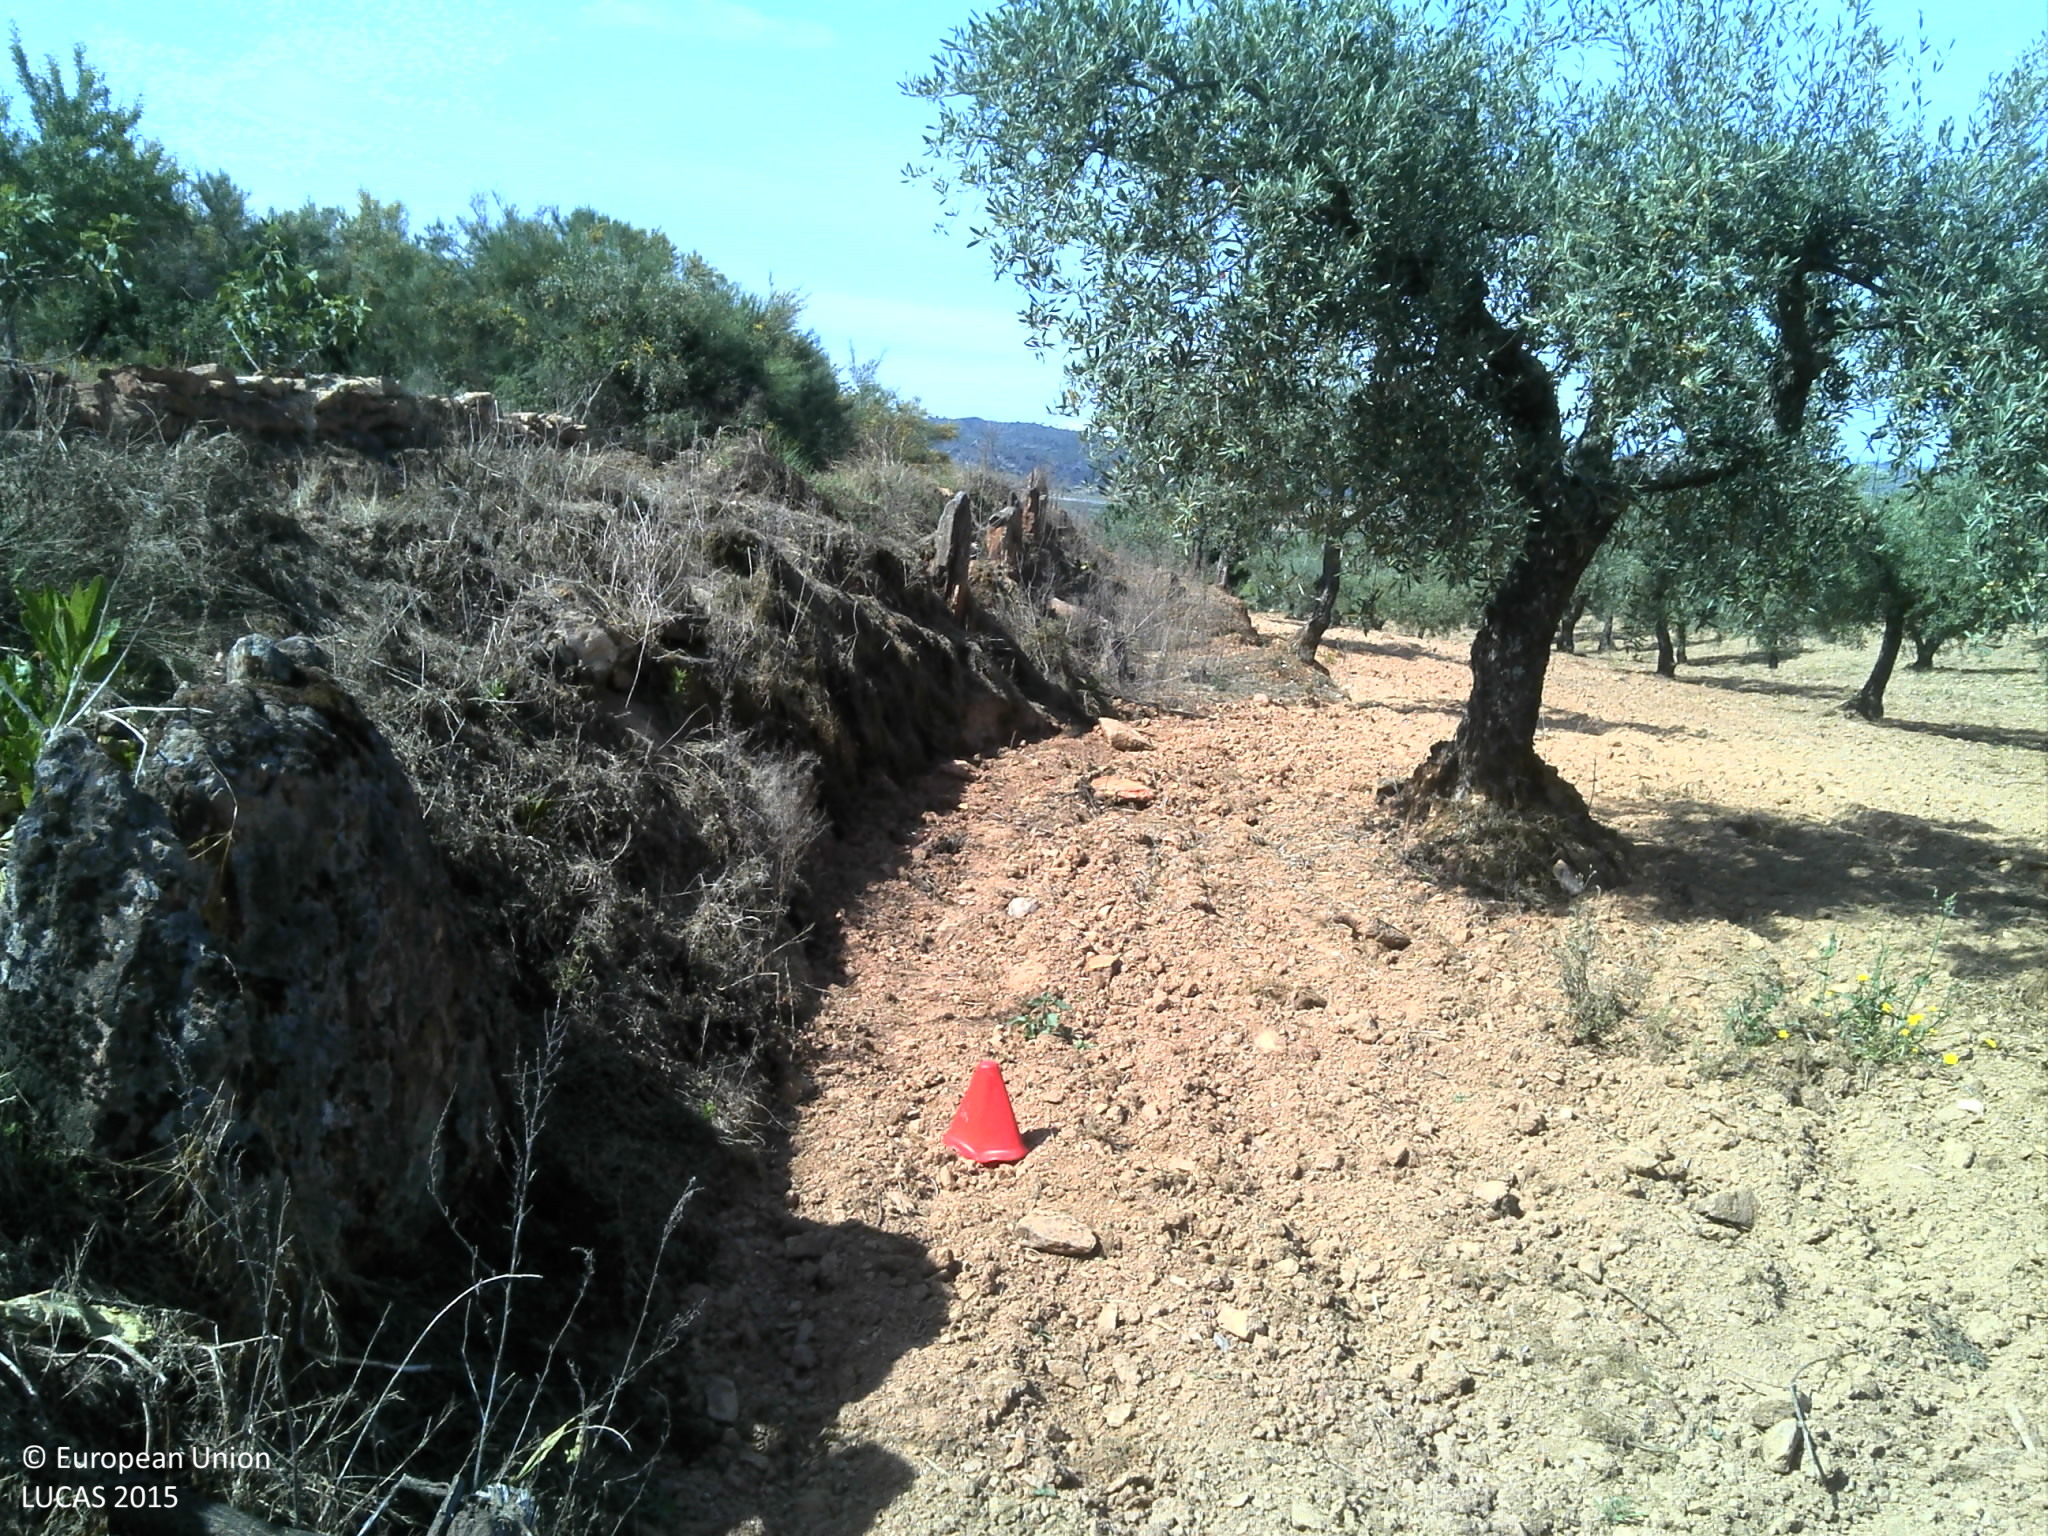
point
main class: Cropland
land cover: Olive groves
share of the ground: 10 - 25 %
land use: Agriculture (excluding fallow land and kitchen gardens)
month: May
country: PT
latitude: 41.5432
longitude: -7.2761
